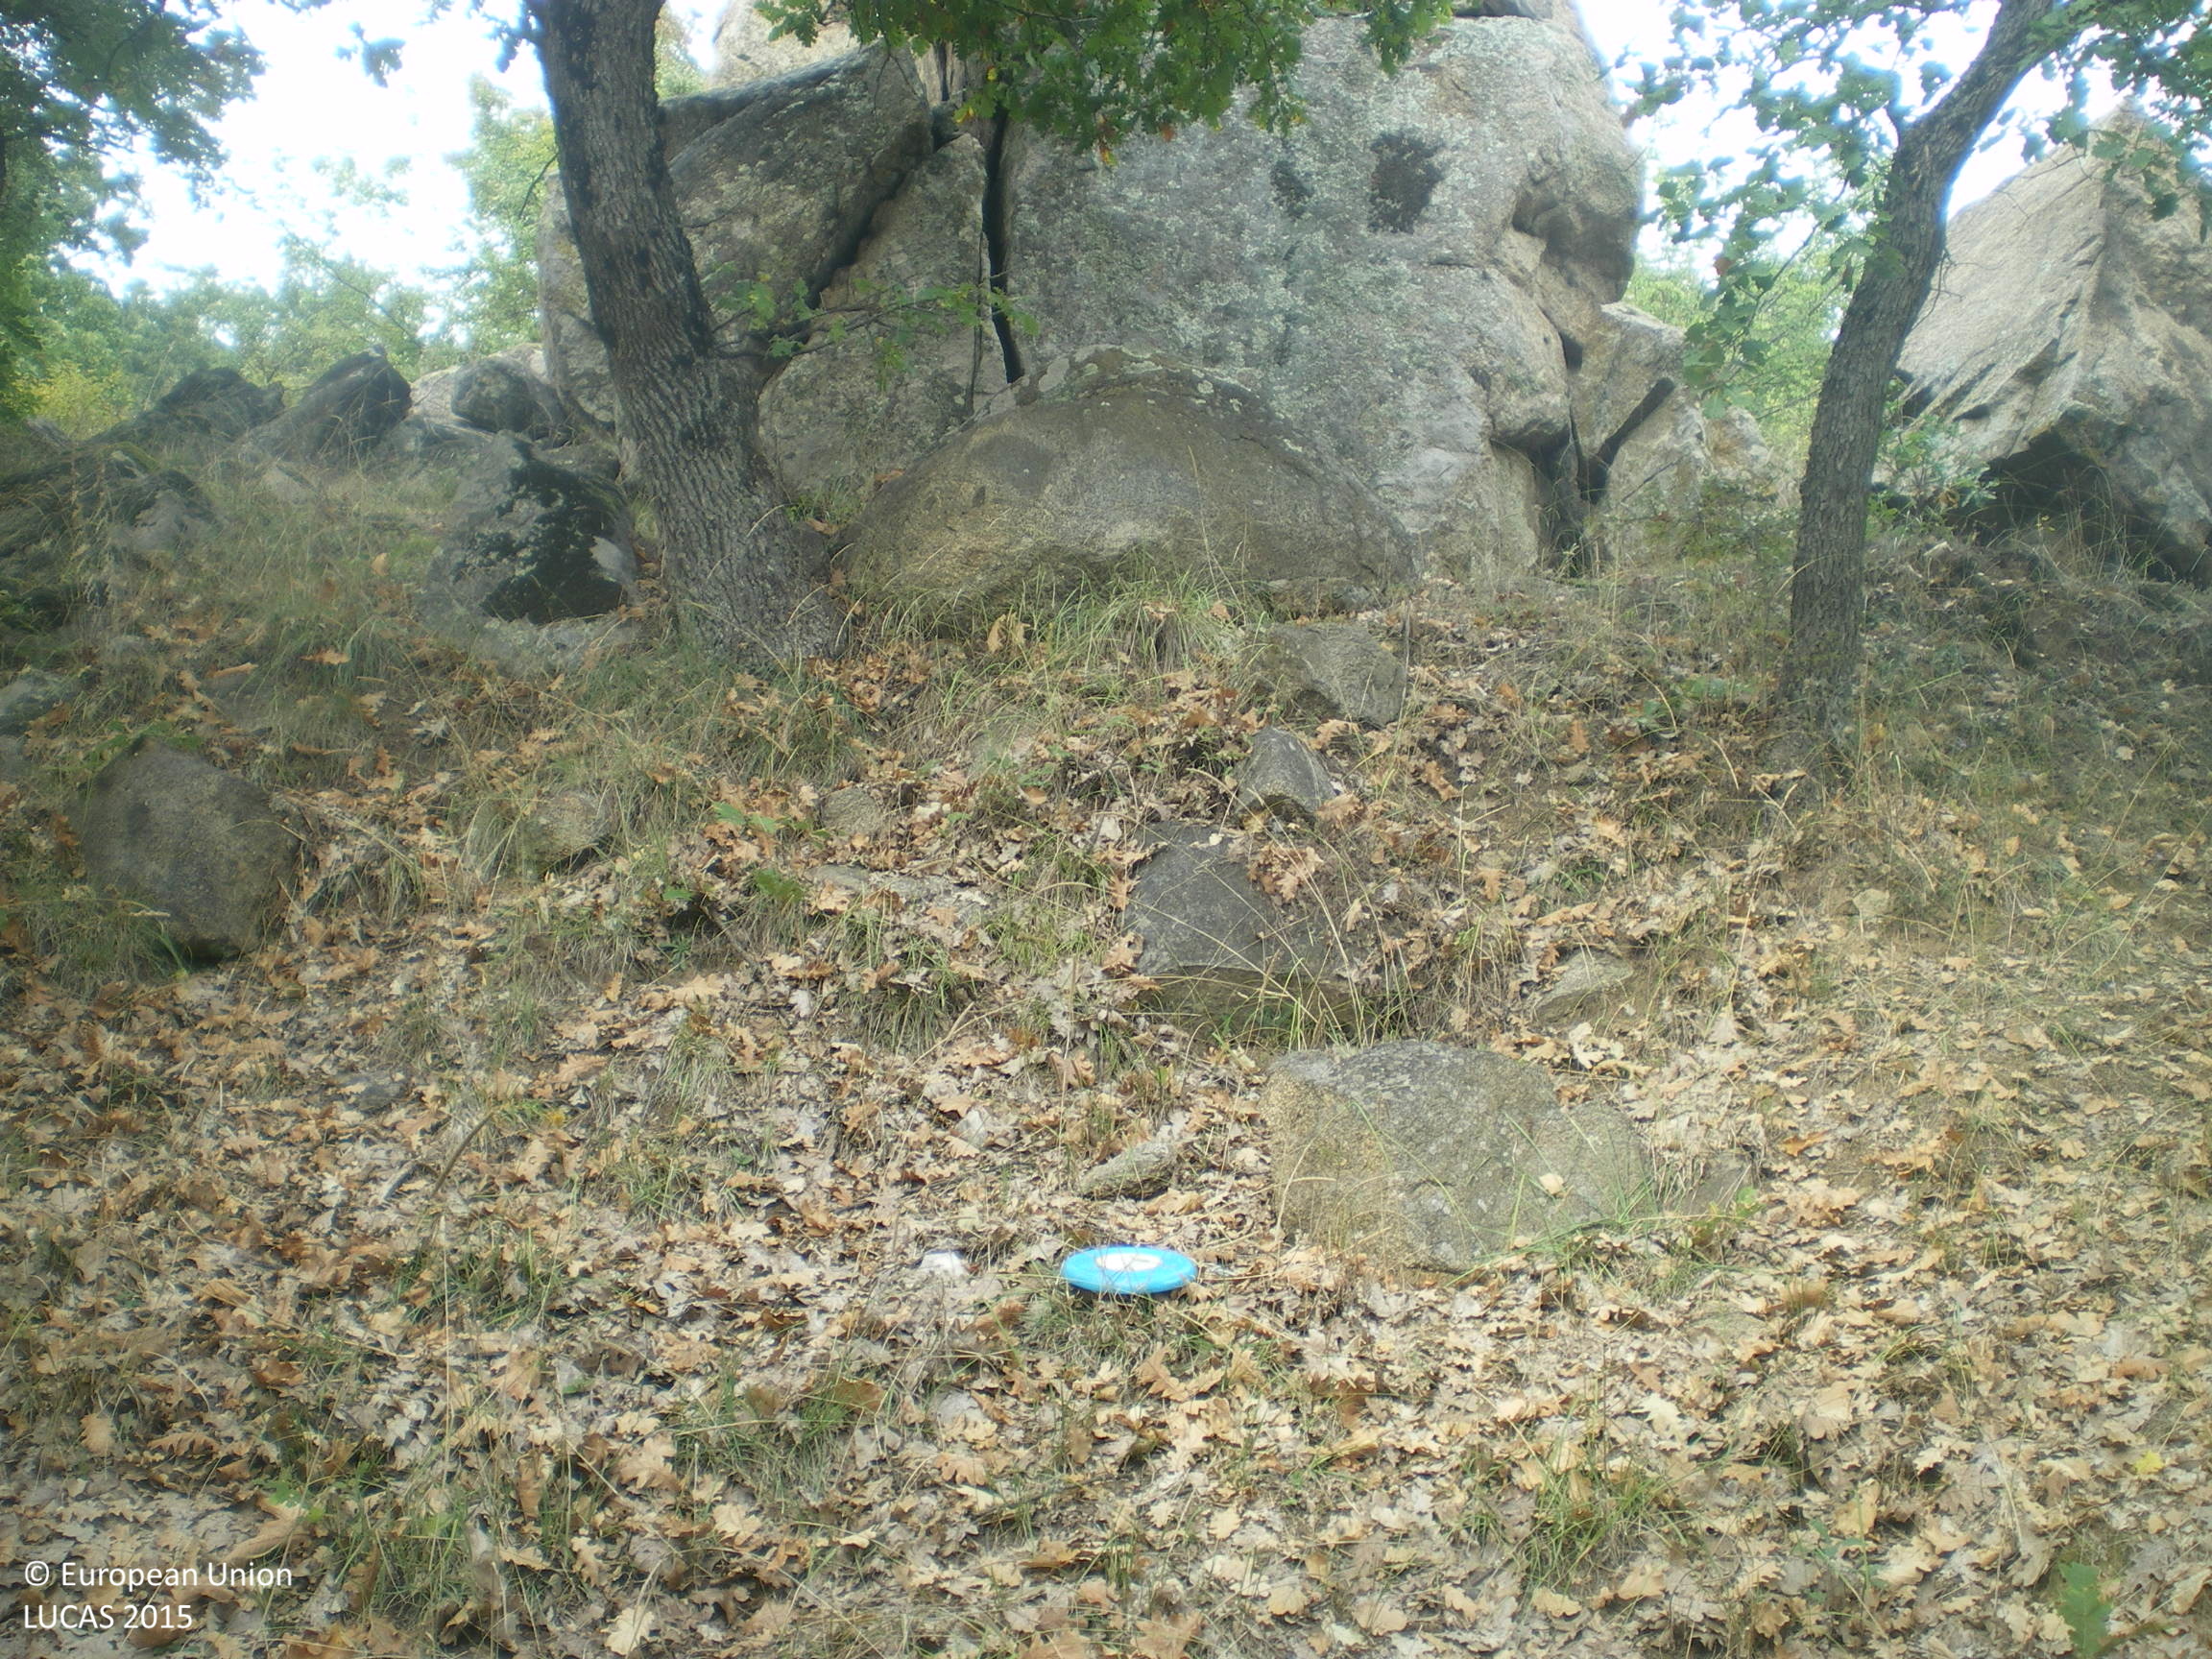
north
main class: Woodland
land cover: Broadleaved woodland
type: mesophytic deciduous forest
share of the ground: > 75 %
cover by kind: broadleaved forest trees 60 %, unconsolidated bare surface 20 %, shrubs 10 %, herbaceous plants 10 %
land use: Forestry
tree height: > 5 m
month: September
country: BG
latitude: 41.8681
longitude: 25.8893
